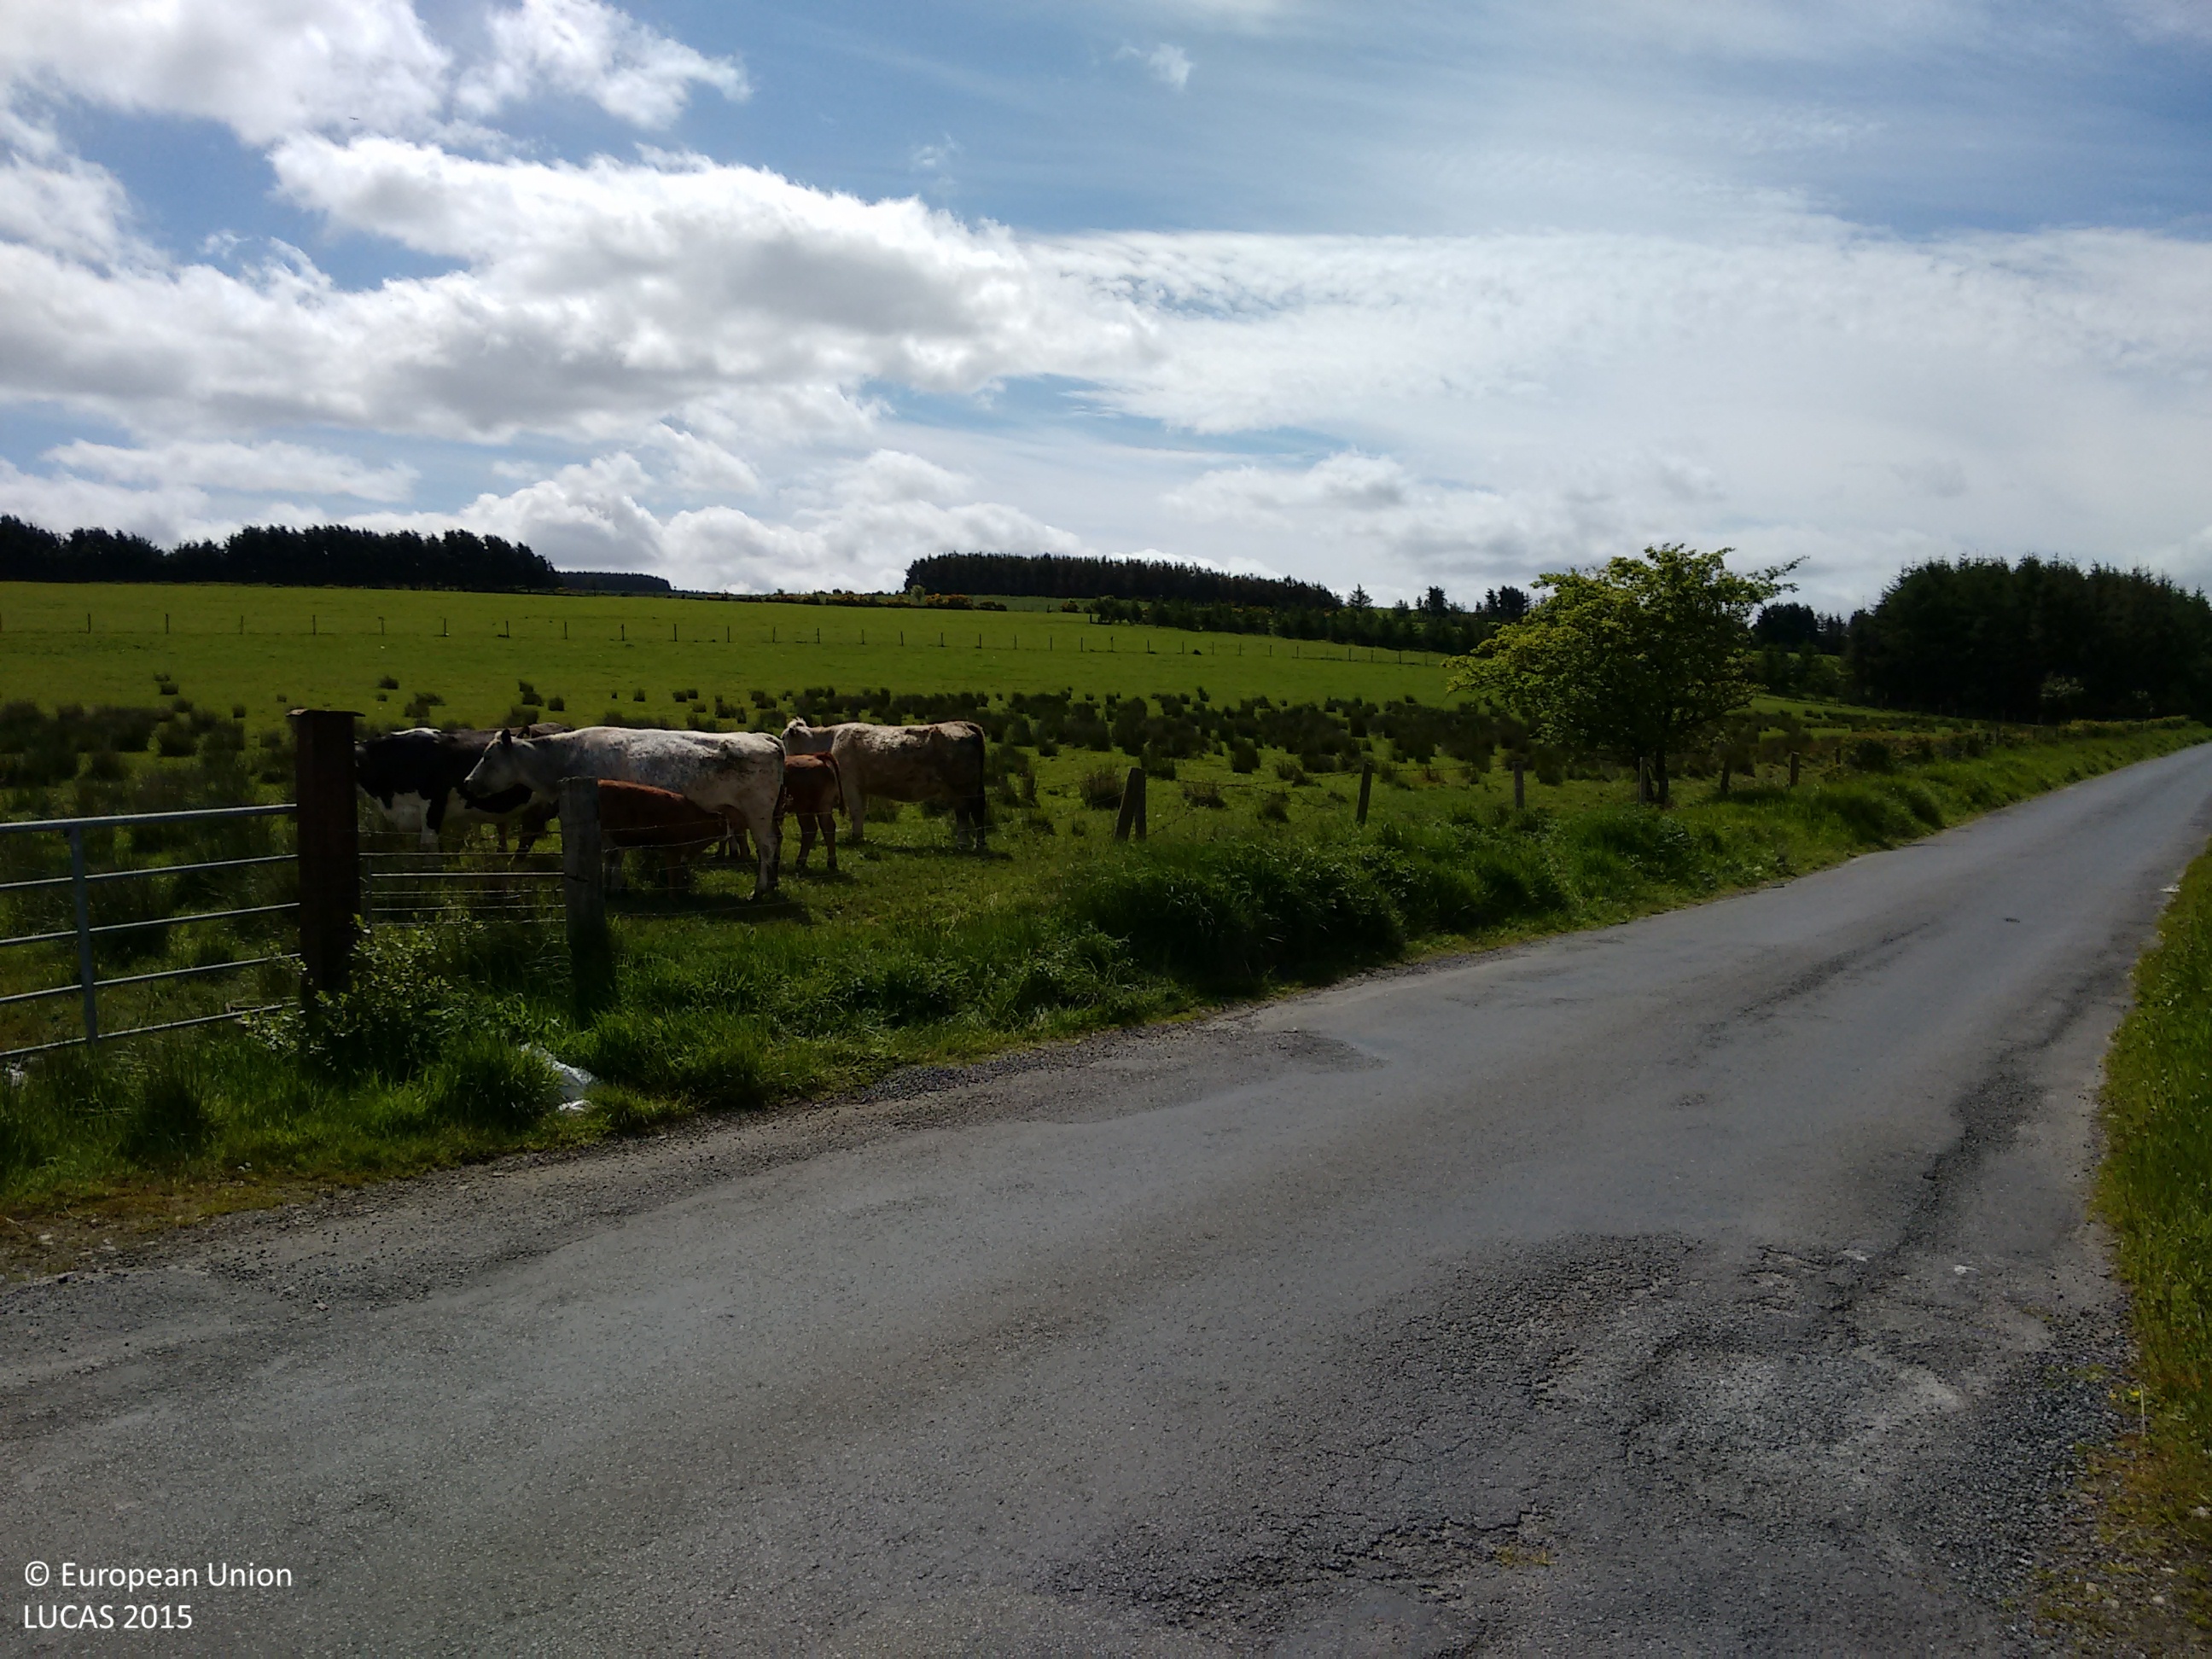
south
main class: Grassland
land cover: Grassland without tree/shrub cover
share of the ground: > 75 %
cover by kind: herbaceous plants 100 %
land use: Agriculture (excluding fallow land and kitchen gardens)
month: June
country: IE
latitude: 53.2189
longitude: -6.4654
